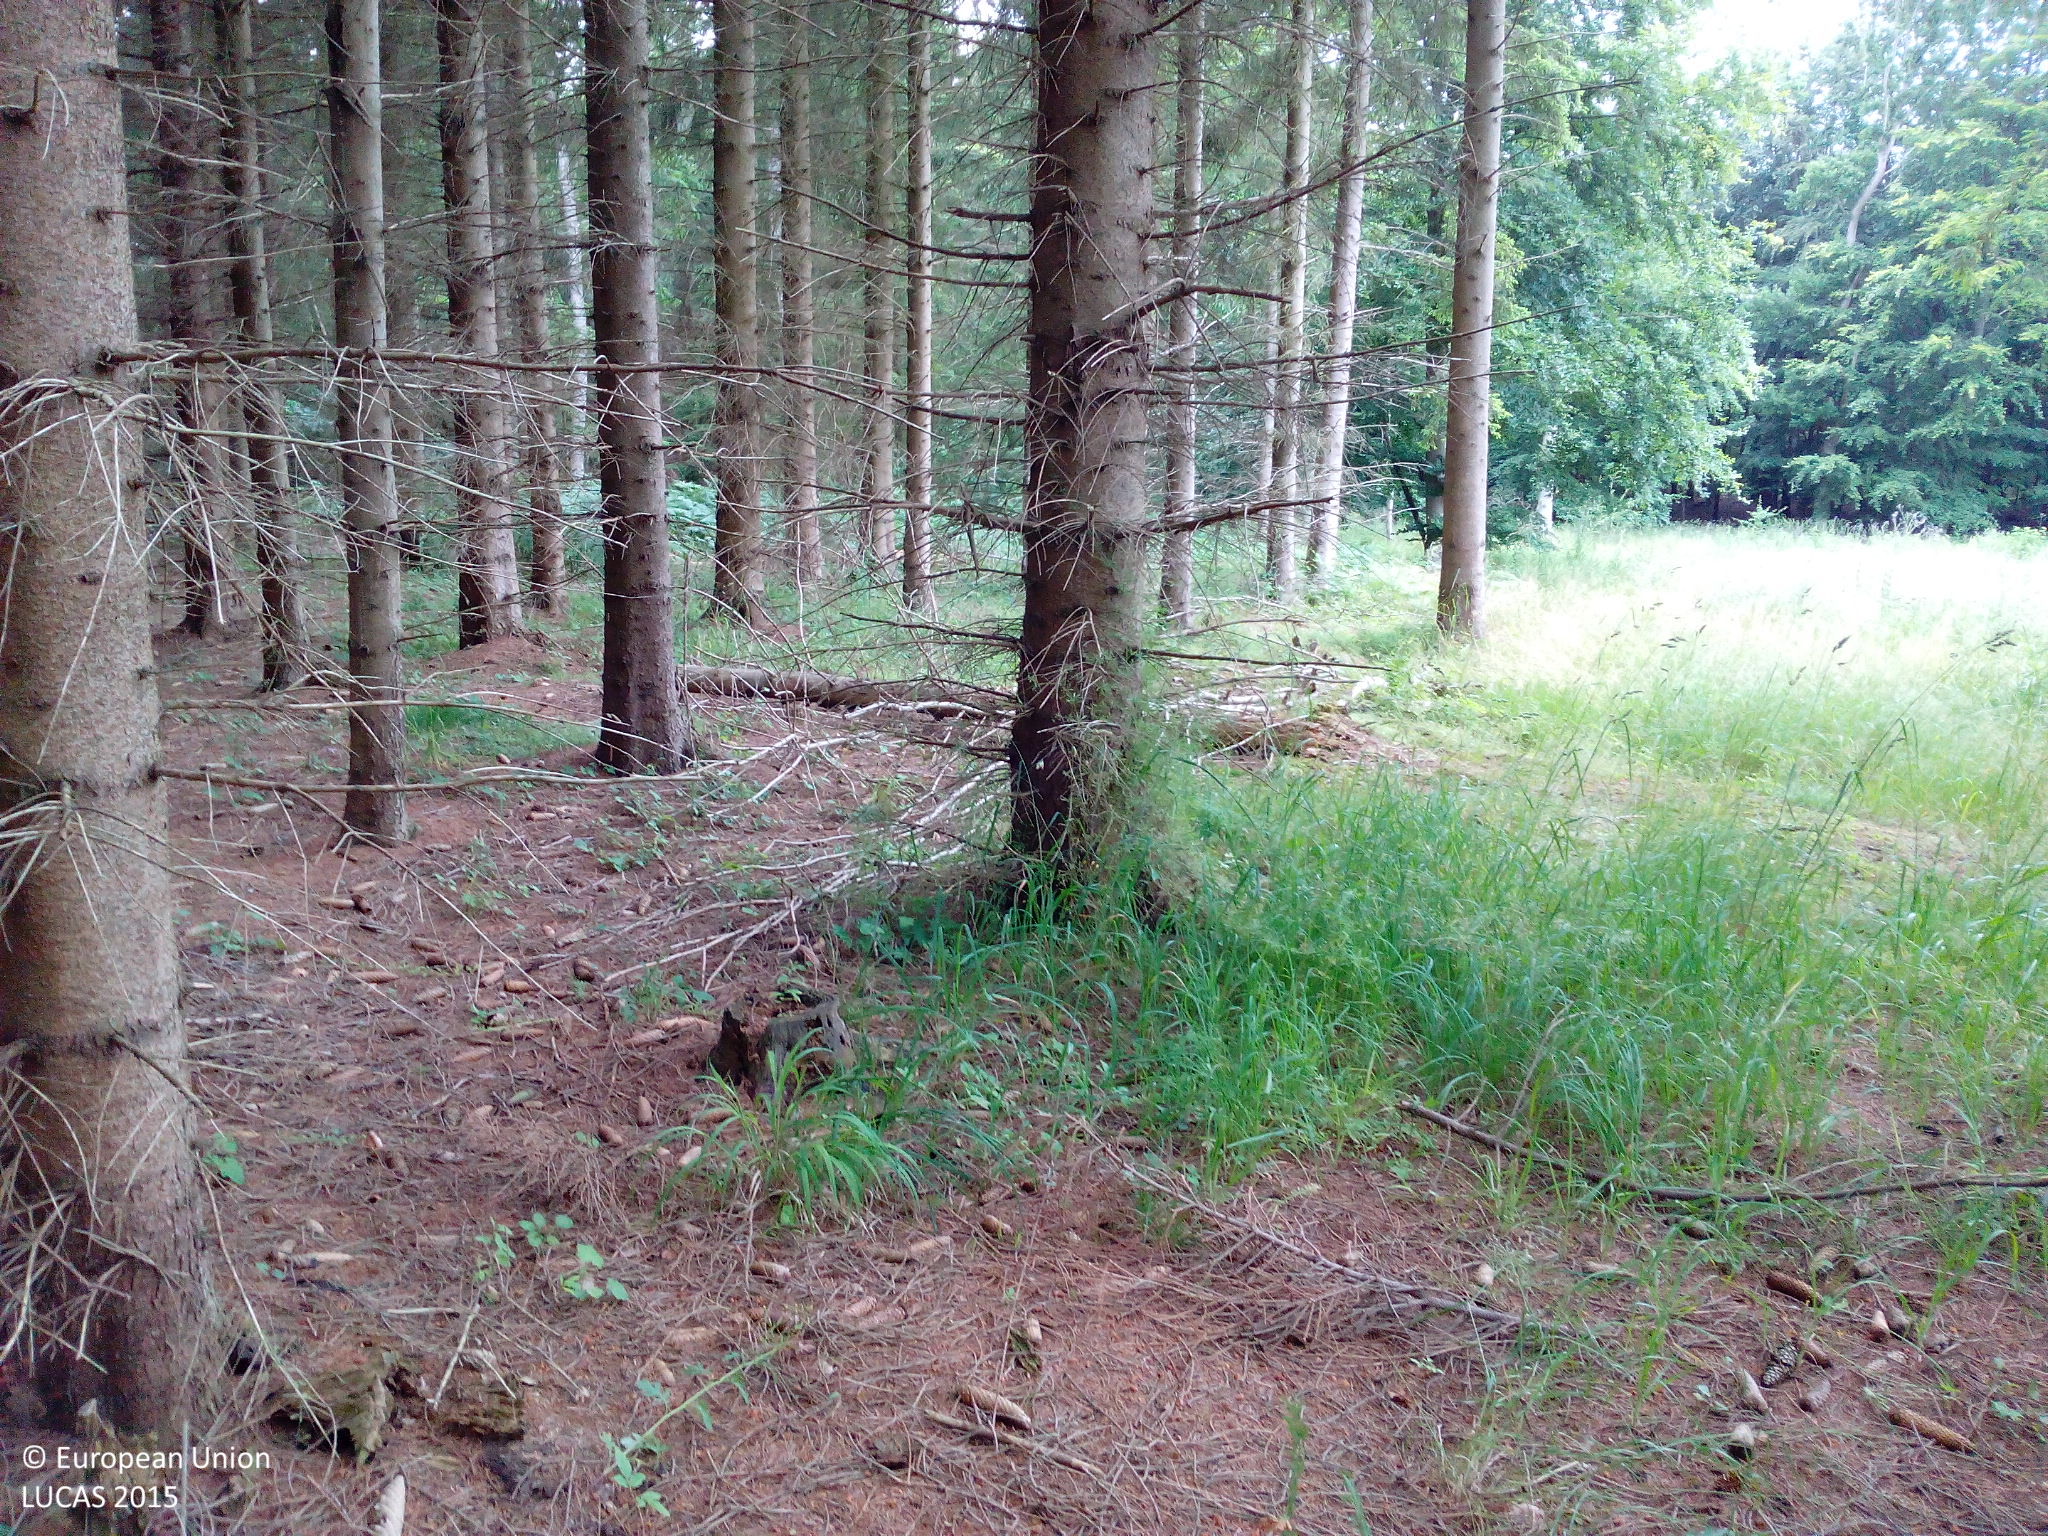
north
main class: Woodland
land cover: Spruce dominated coniferous woodland
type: hemiboreal forest and nemoral coniferous forest and mixed broadleaved-coniferous forest
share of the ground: > 75 %
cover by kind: coniferous forest trees 80 %, herbaceous plants 10 %, unconsolidated bare surface 10 %
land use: Forestry
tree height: > 5 m
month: July
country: DK
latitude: 55.1888
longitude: 11.6166
